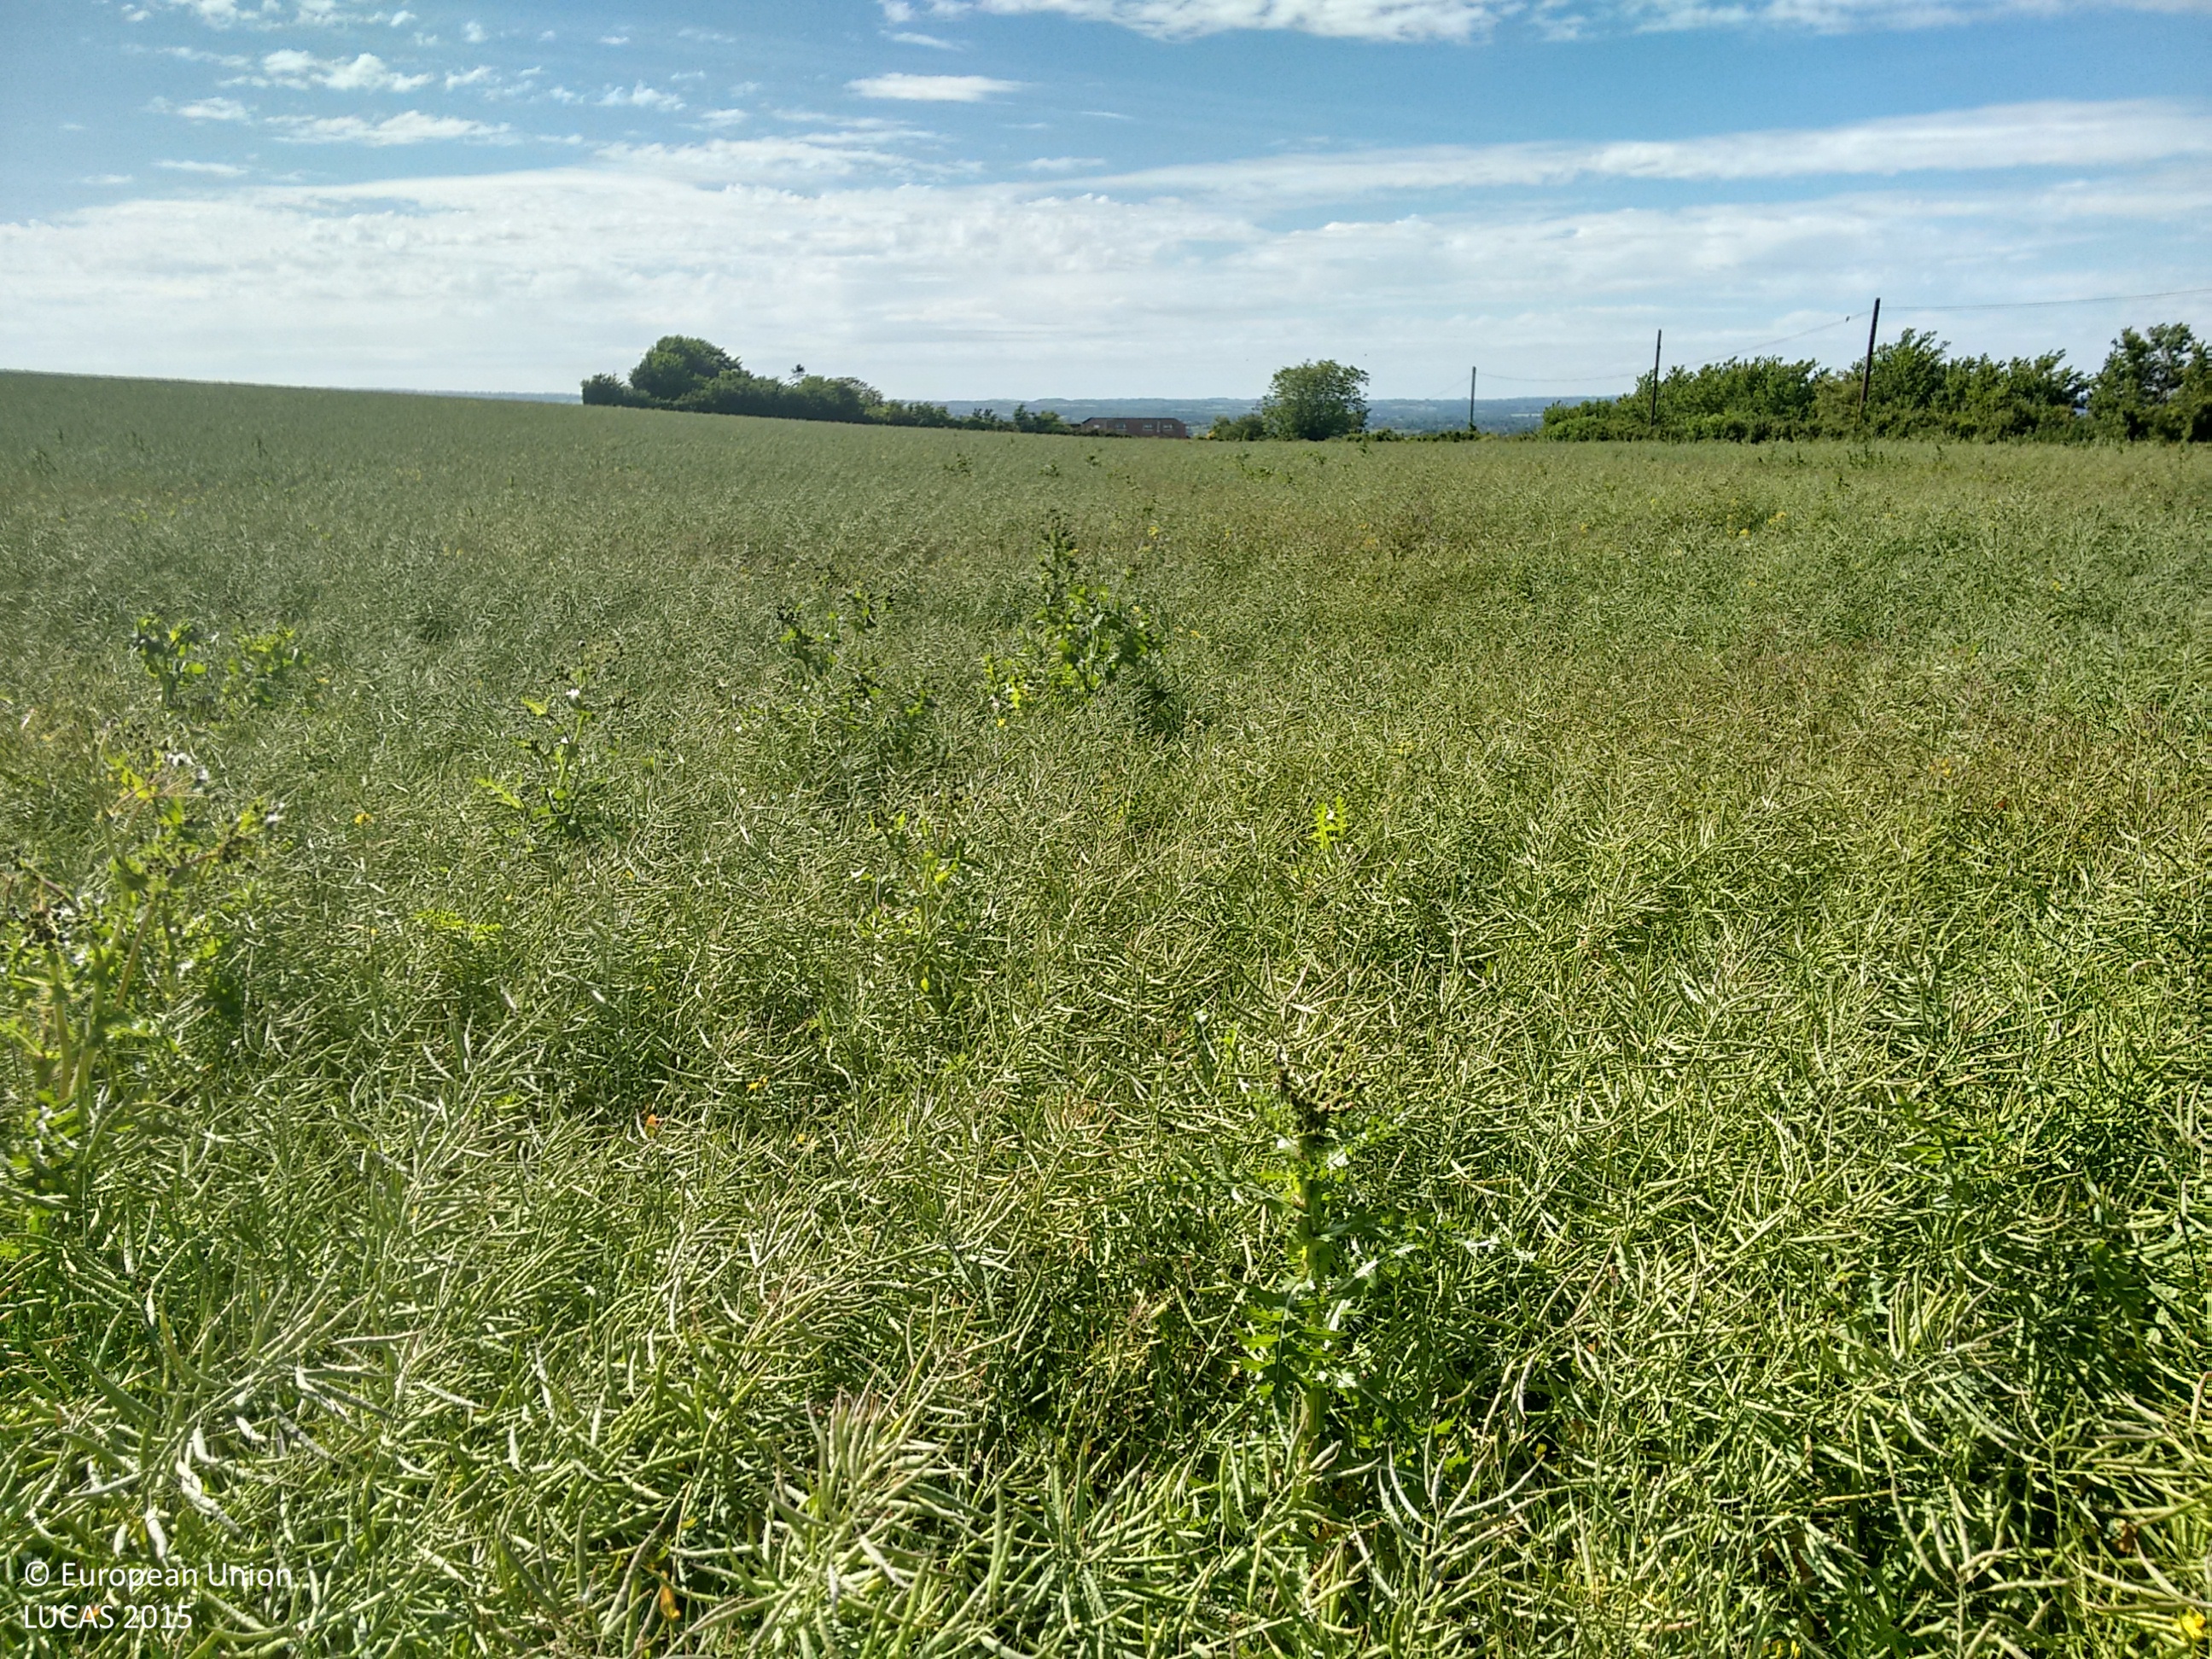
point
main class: Cropland
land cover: Rape and turnip rape
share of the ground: > 75 %
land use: Agriculture (excluding fallow land and kitchen gardens)
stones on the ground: 10 - 25 %
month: June
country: GB
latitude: 51.2574
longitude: -2.1694
